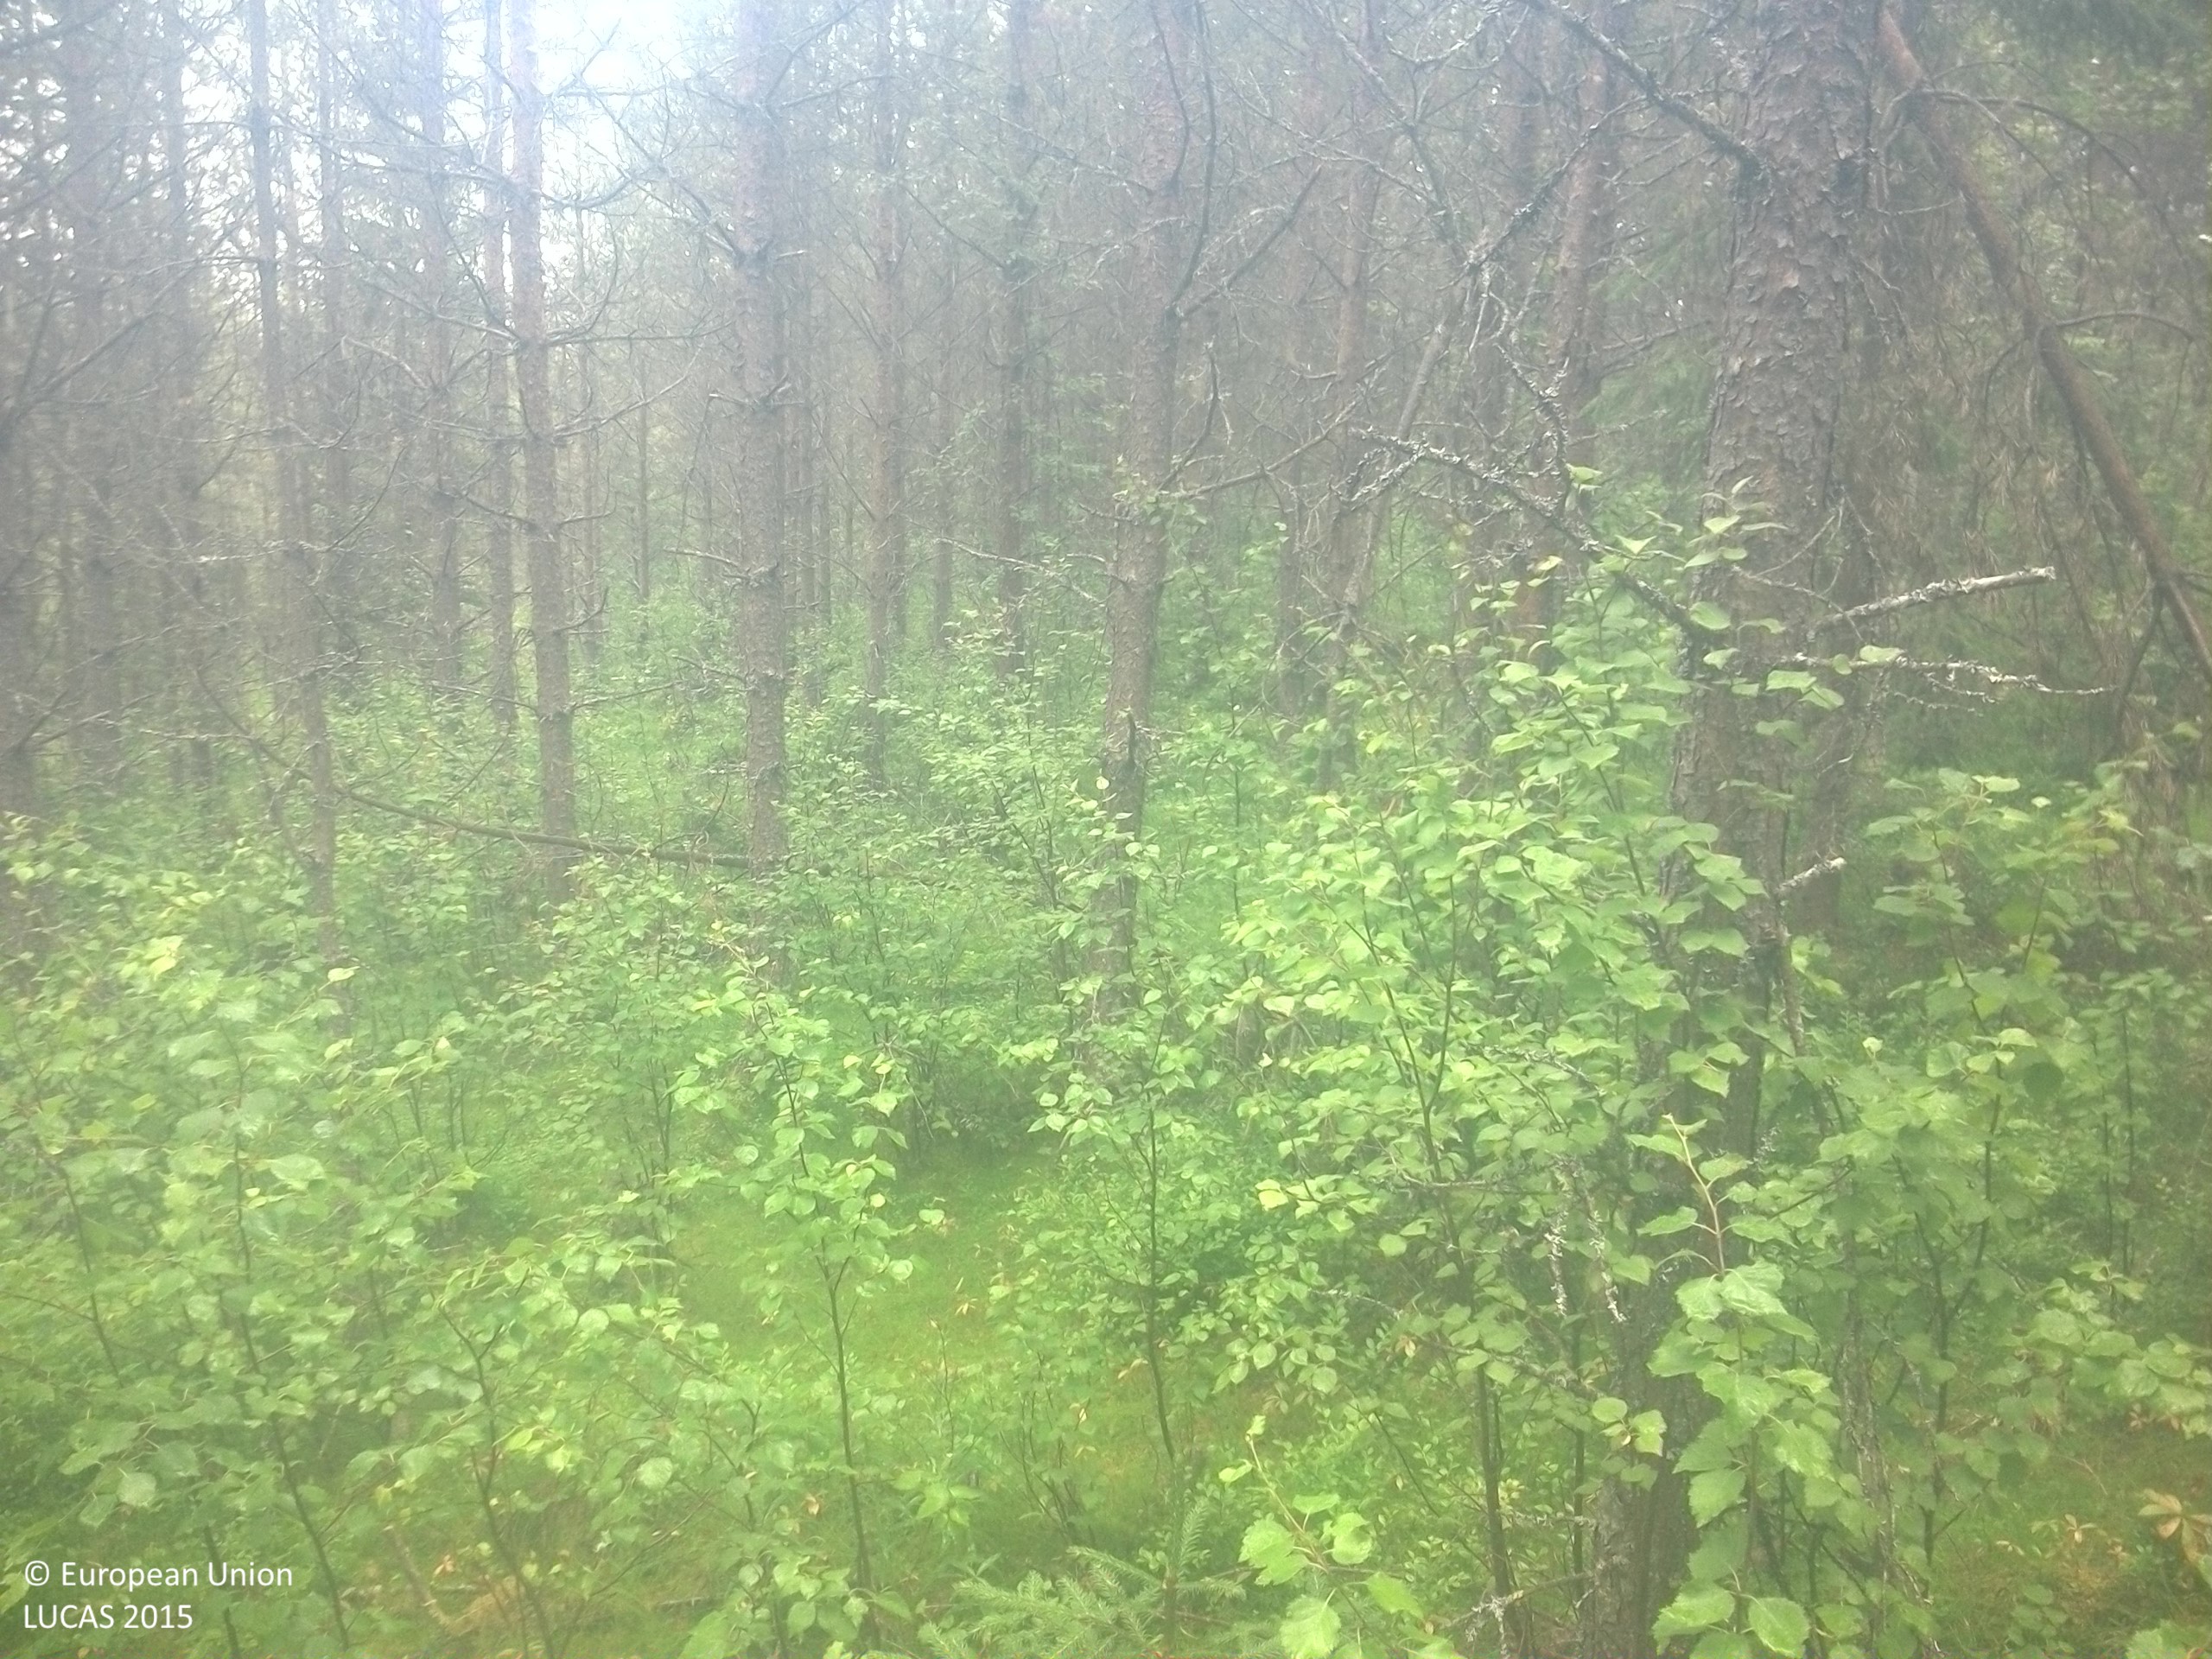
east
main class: Woodland
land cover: Pine dominated coniferous woodland
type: boreal forest
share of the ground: 50 - 75 %
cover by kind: coniferous forest trees 45 %, shrubs 20 %, herbaceous plants 15 %, broadleaved forest trees 10 %, lichens and mosses 10 %
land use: Forestry
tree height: > 5 m
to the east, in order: Pine dominated coniferous woodland; Pine dominated mixed woodland; Broadleaved woodland; Rivers and streams; Spruce dominated mixed woodland; Spruce dominated coniferous woodland
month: August
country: SE
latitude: 63.5364
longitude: 16.5908
